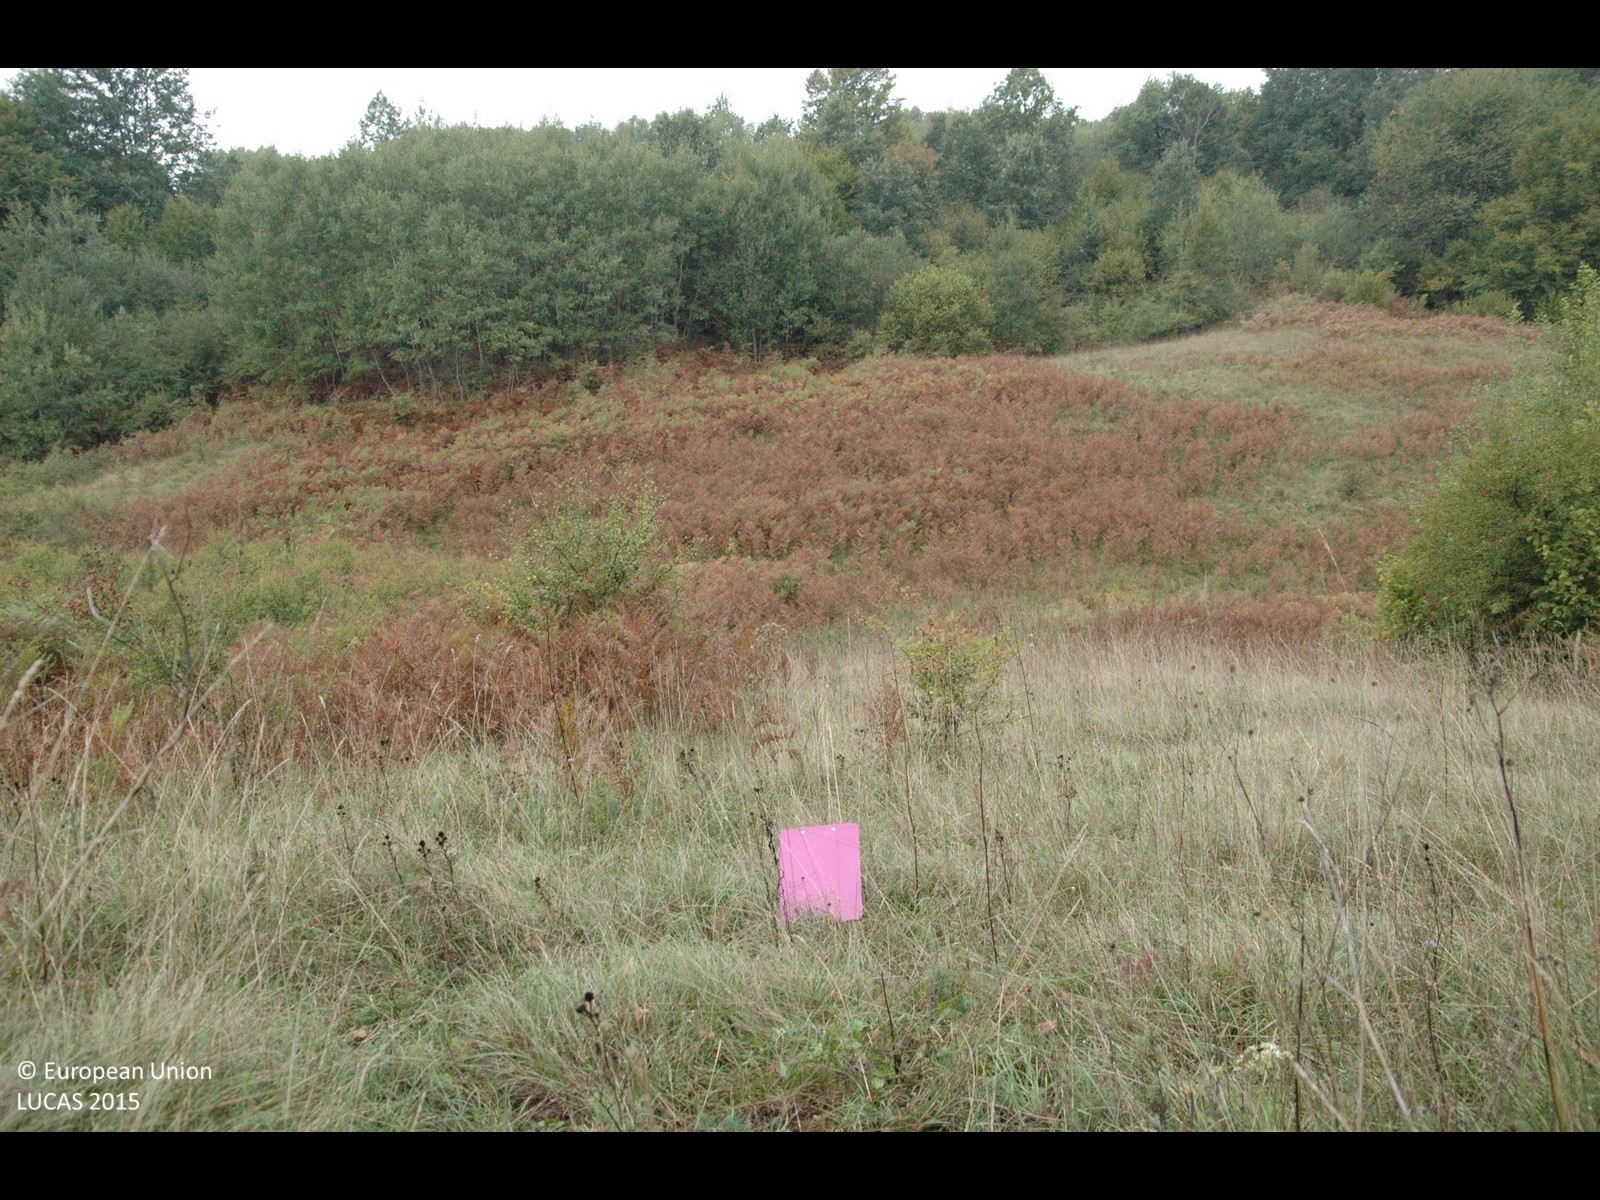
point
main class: Grassland
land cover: Grassland without tree/shrub cover
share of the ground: > 75 %
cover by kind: herbaceous plants 100 %
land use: Semi-natural and natural areas not in use
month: September
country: HR
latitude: 45.0463
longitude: 15.6449
